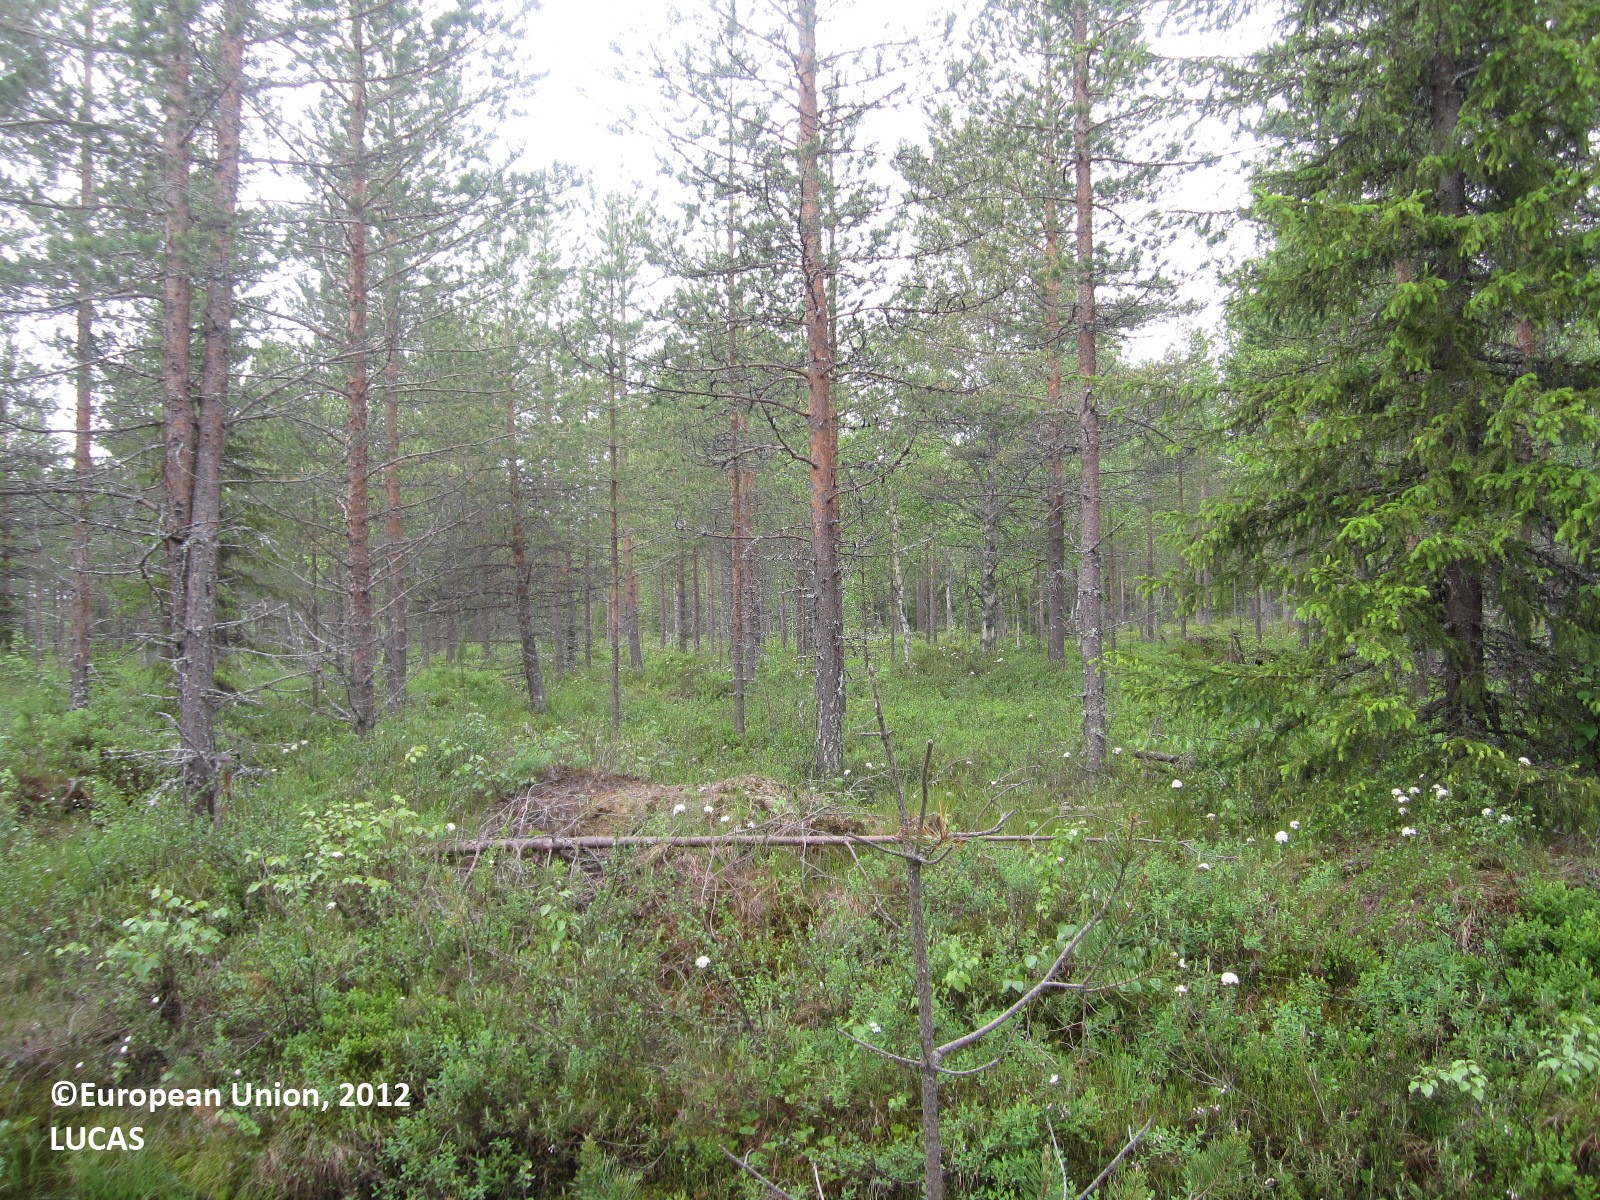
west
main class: Woodland
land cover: Pine dominated coniferous woodland
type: boreal forest
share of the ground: 50 - 75 %
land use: Forestry
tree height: > 5 m
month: June
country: FI
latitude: 64.7455
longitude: 29.7787
